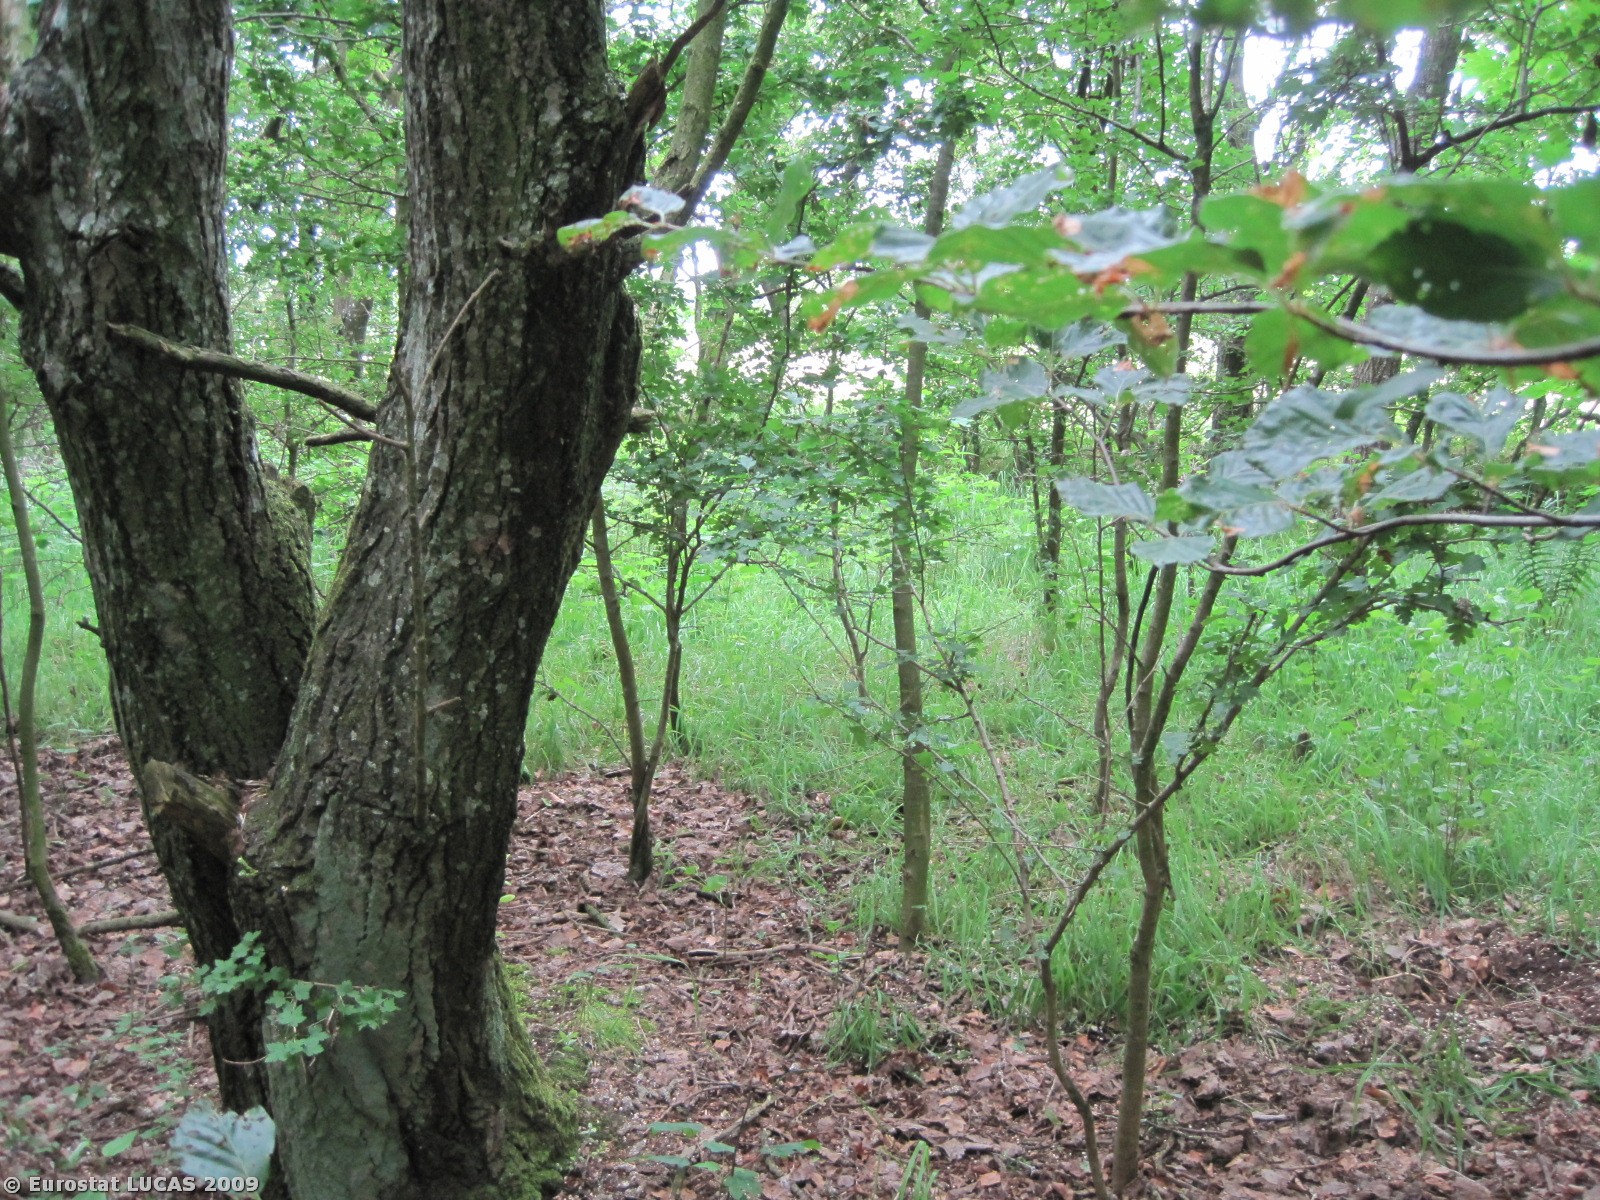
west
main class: Woodland
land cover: Broadleaved woodland
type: plantations and self-sown exotic forest
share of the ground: > 75 %
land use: Unused
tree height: > 5 m
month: June
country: DK
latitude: 57.2124
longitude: 10.0496
